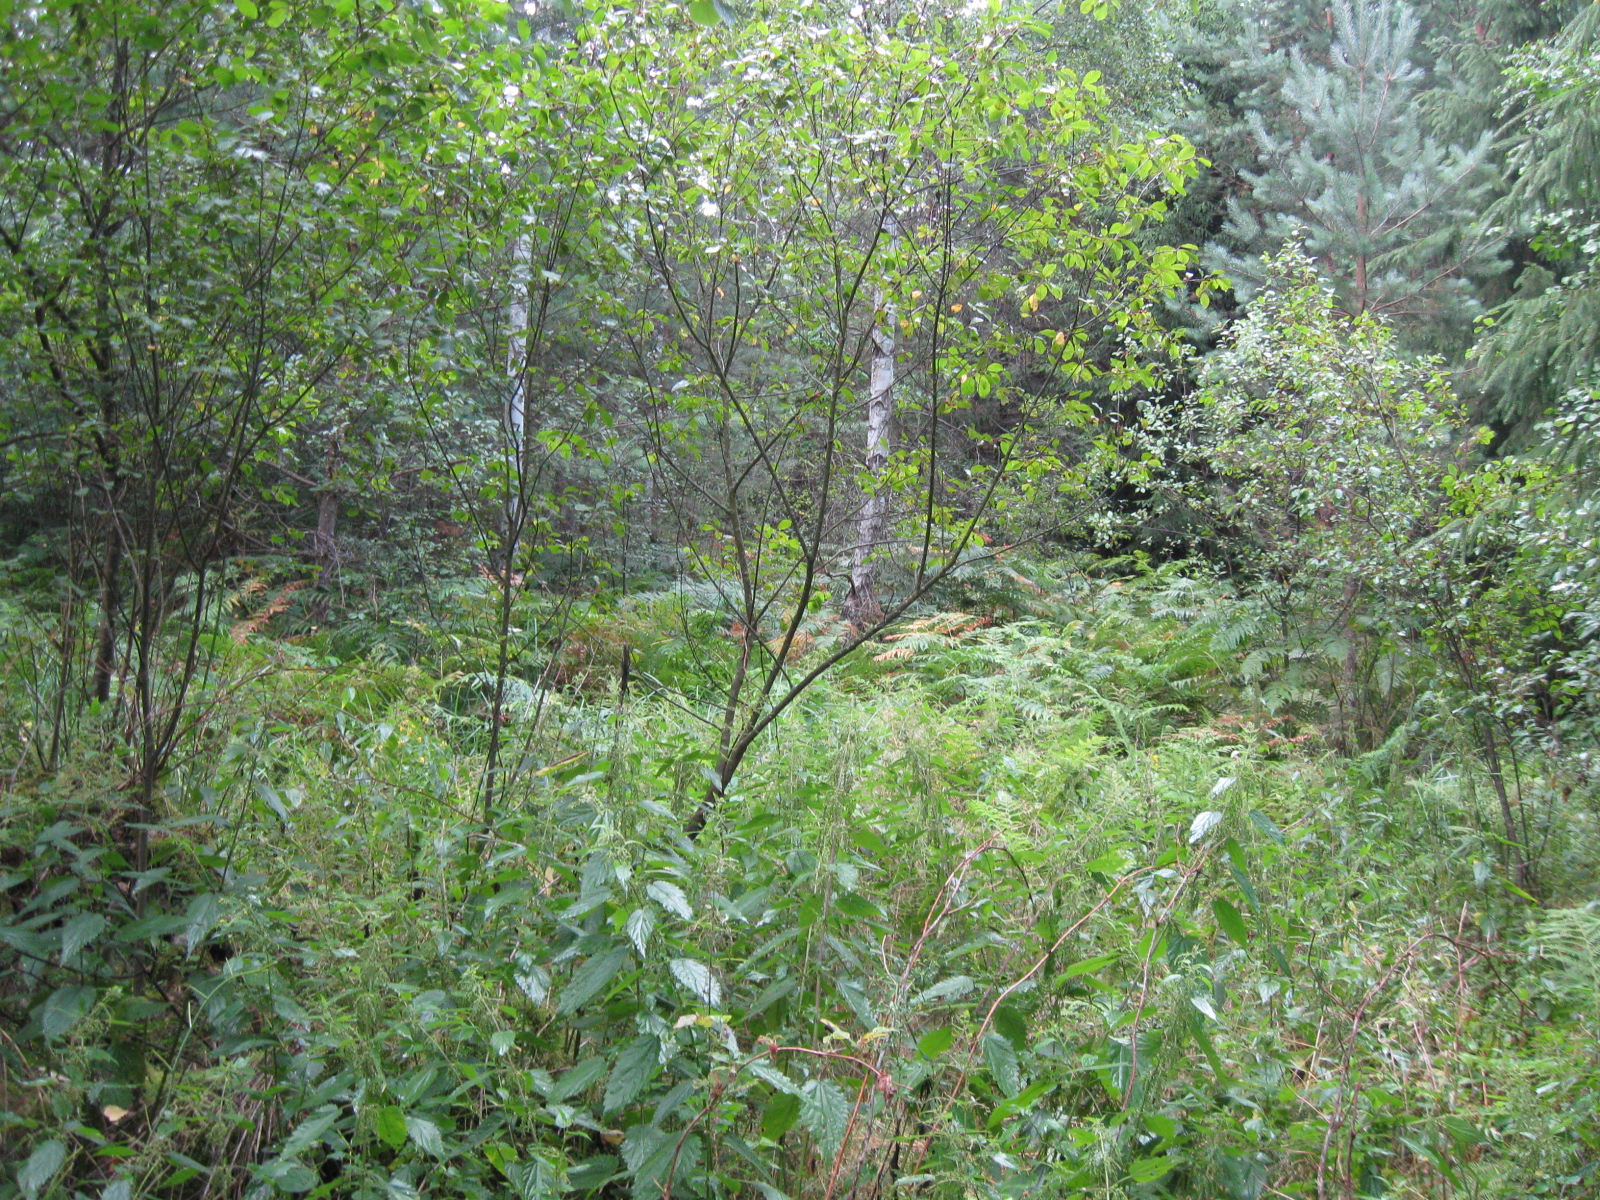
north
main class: Woodland
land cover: Broadleaved woodland
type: non-riverine alder, birch or aspen forest
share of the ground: > 75 %
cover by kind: broadleaved forest trees 70 %, herbaceous plants 20 %, coniferous forest trees 10 %
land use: Forestry
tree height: > 5 m
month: July
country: LT
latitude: 54.9315
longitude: 23.5820
